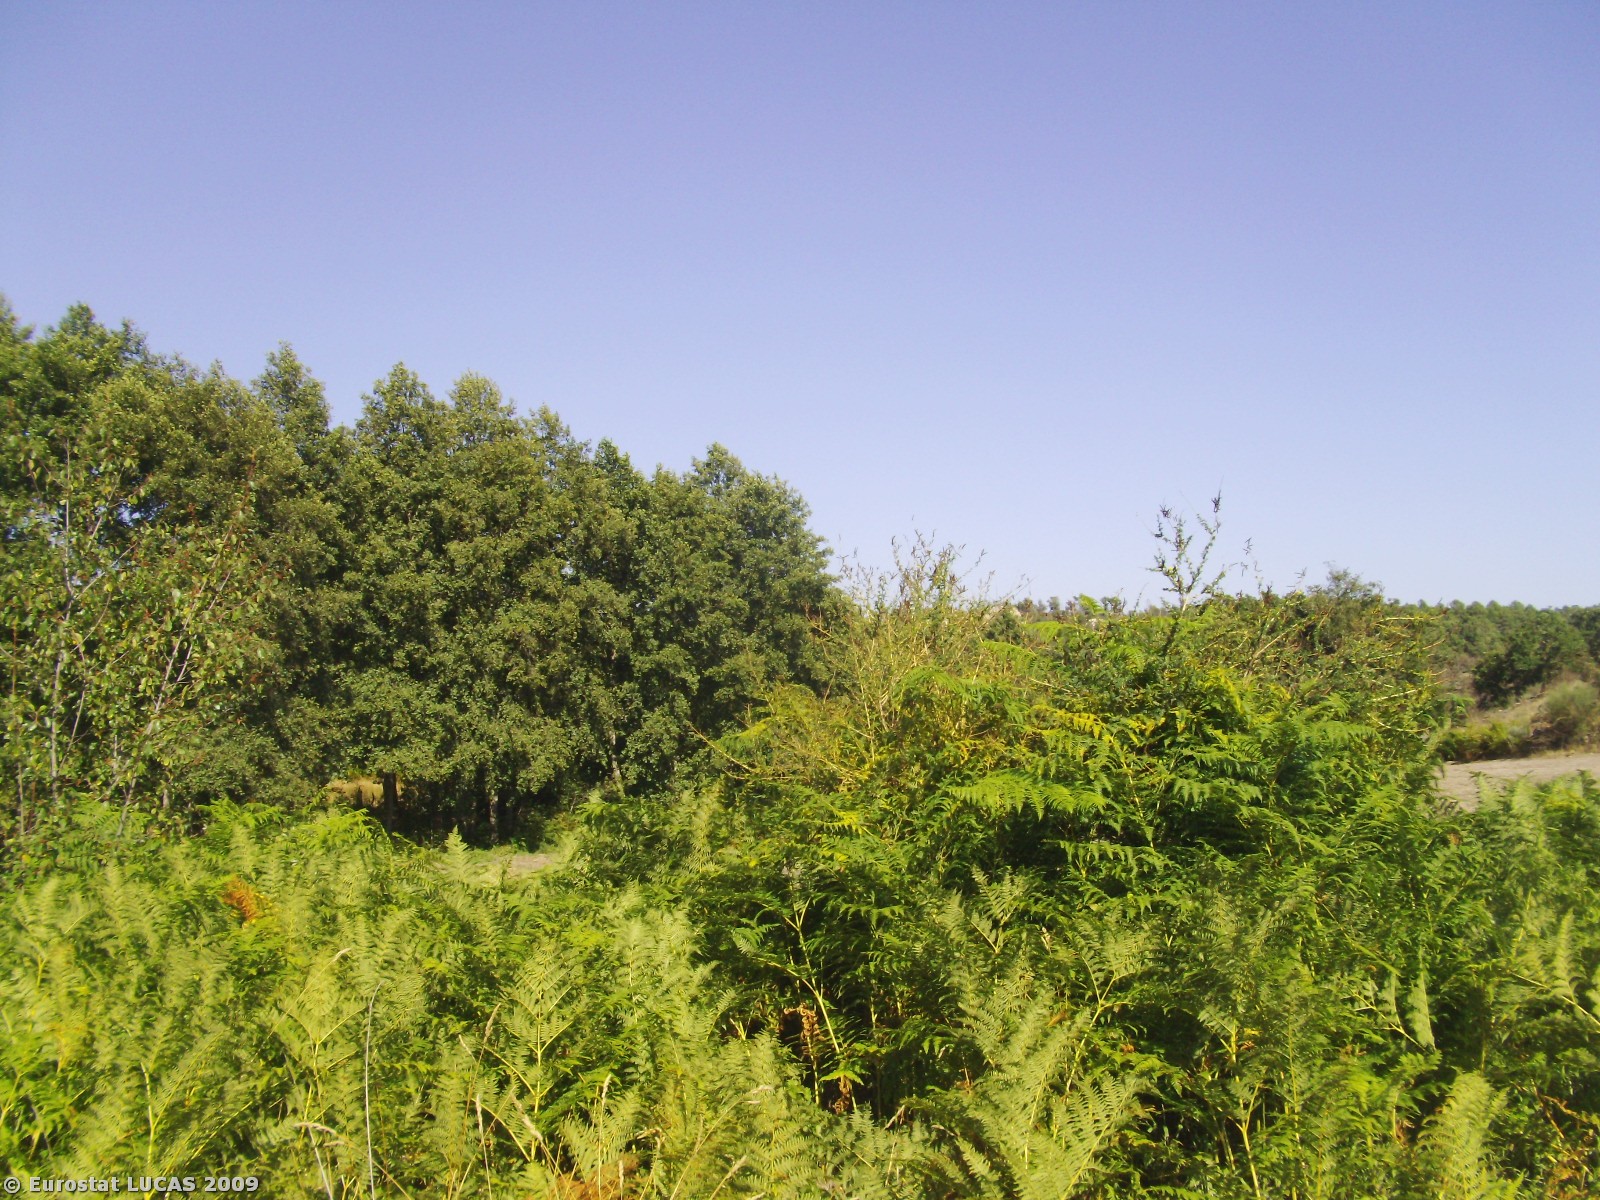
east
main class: Grassland
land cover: Spontaneously vegetated surfaces
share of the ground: > 75 %
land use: Fallow land
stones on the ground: < 10 %
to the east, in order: Spontaneously vegetated surfaces; Shruby margins; Spontaneously vegetated surfaces; Tracks; Abandoned hedges; Spontaneously vegetated surfaces; Tracks; Abandoned hedges; Rivers and streams; Spontaneously vegetated surfaces; Abandoned hedges; Shrubland with sparse tree cover; Rivers and streams; Spontaneously vegetated surfaces
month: August
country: PT
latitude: 41.7430
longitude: -7.6054
